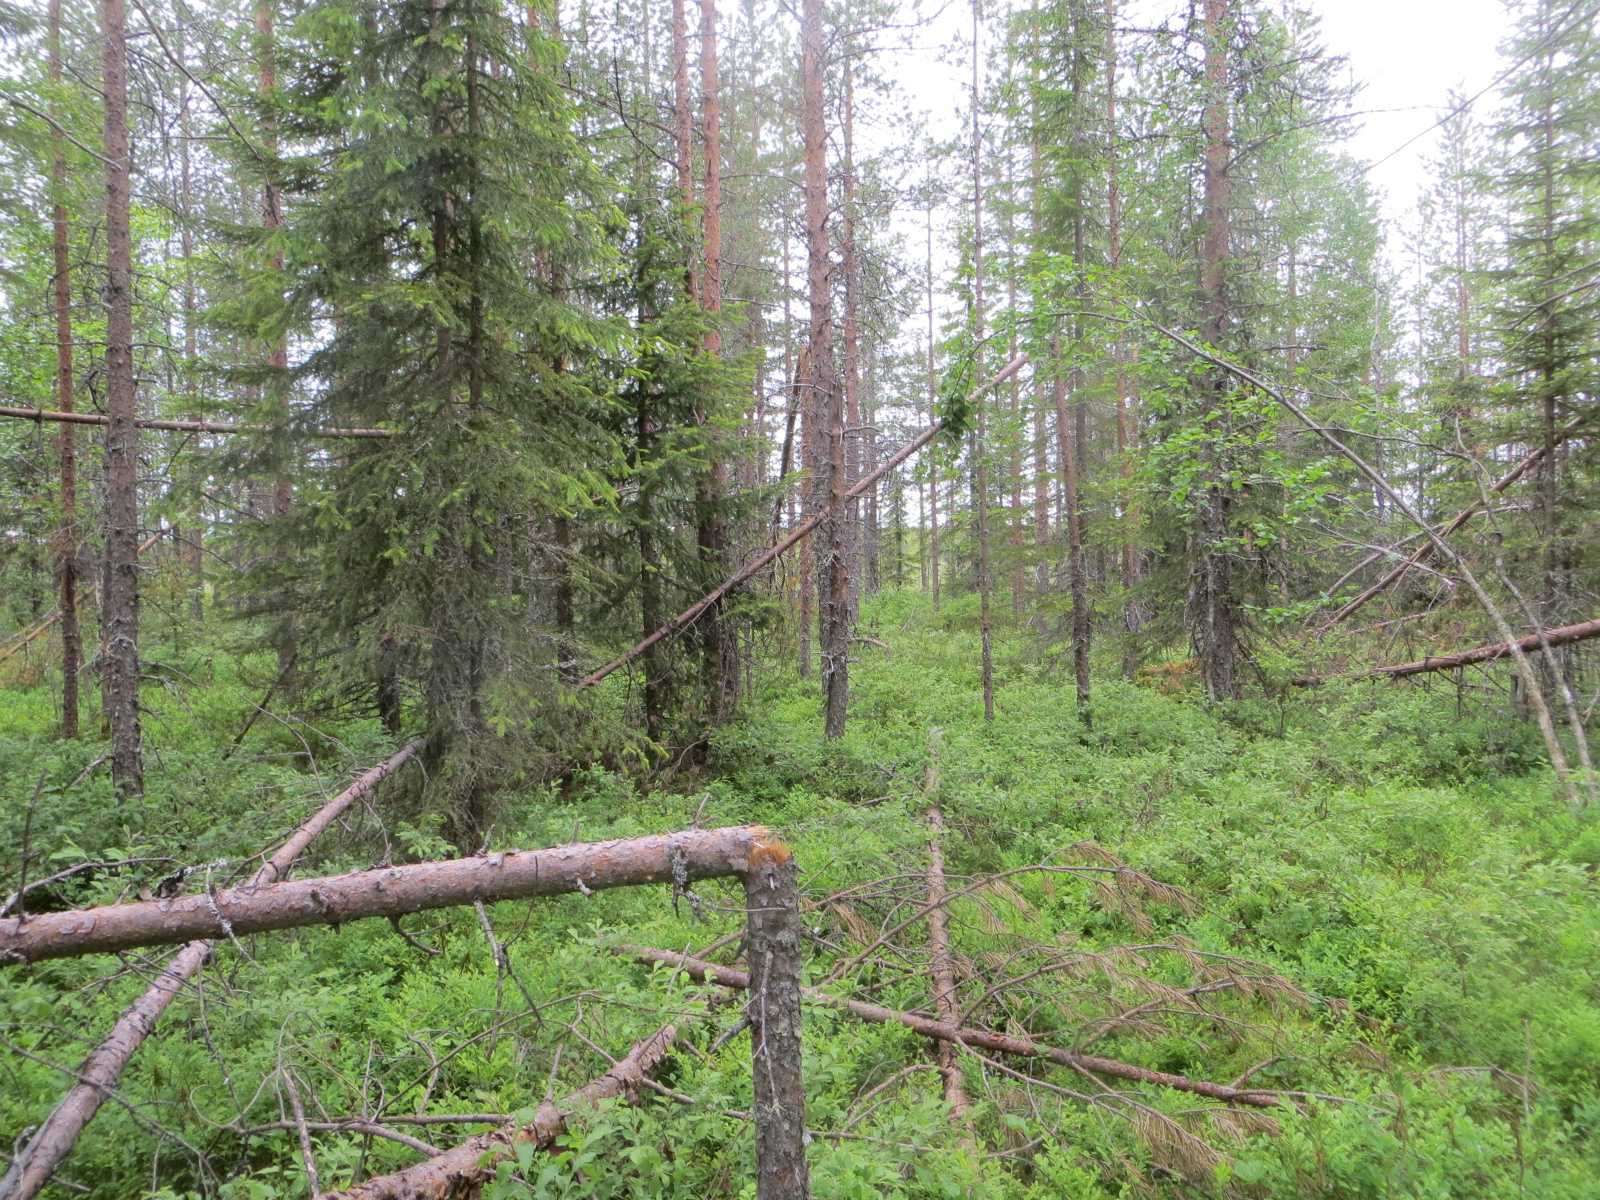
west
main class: Woodland
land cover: Other coniferous woodland
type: boreal forest
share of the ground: 50 - 75 %
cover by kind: coniferous forest trees 60 %, shrubs 30 %, broadleaved forest trees 10 %
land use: Forestry
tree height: > 5 m
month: July
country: FI
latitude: 65.7339
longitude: 25.3576
